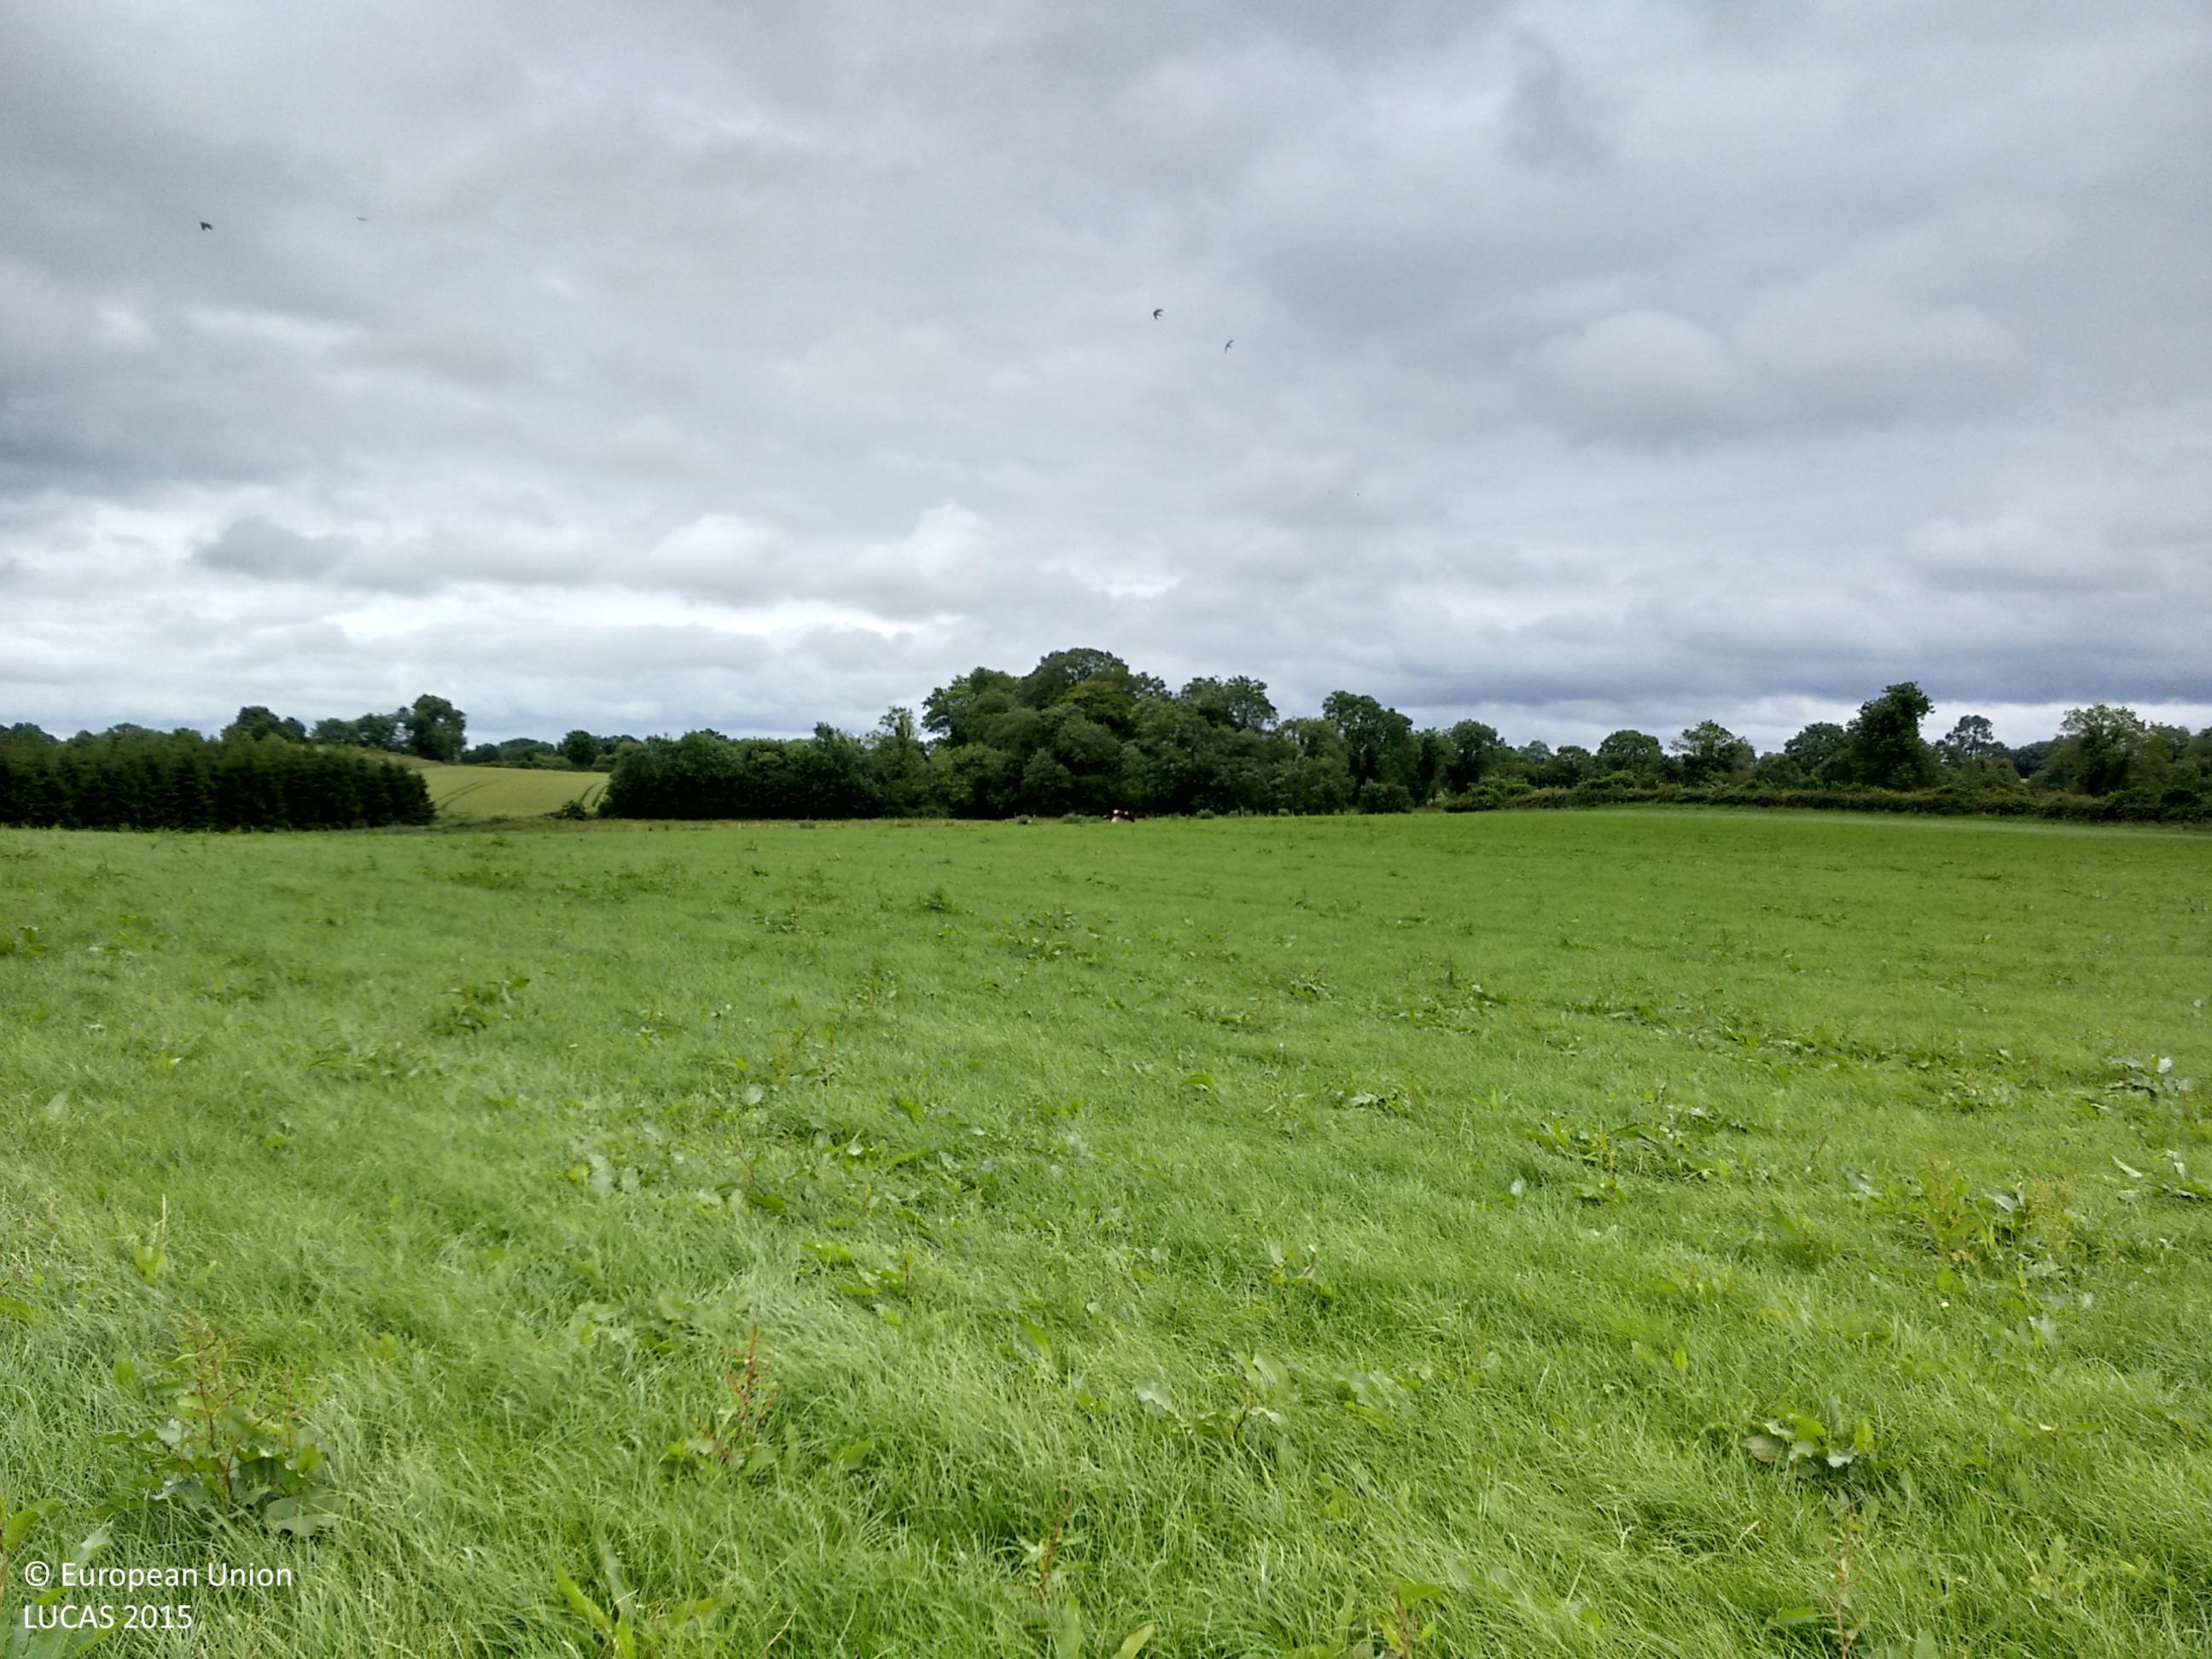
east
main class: Grassland
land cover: Grassland without tree/shrub cover
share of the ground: > 75 %
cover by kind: herbaceous plants 100 %
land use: Agriculture (excluding fallow land and kitchen gardens)
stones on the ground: < 10 %
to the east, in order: Grassland without tree/shrub cover; Fences; Grassland without tree/shrub cover; Fences; Rivers and streams; Managed hedges; Grassland without tree/shrub cover; Broadleaved woodland
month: July
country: IE
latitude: 53.5966
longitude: -7.0512
